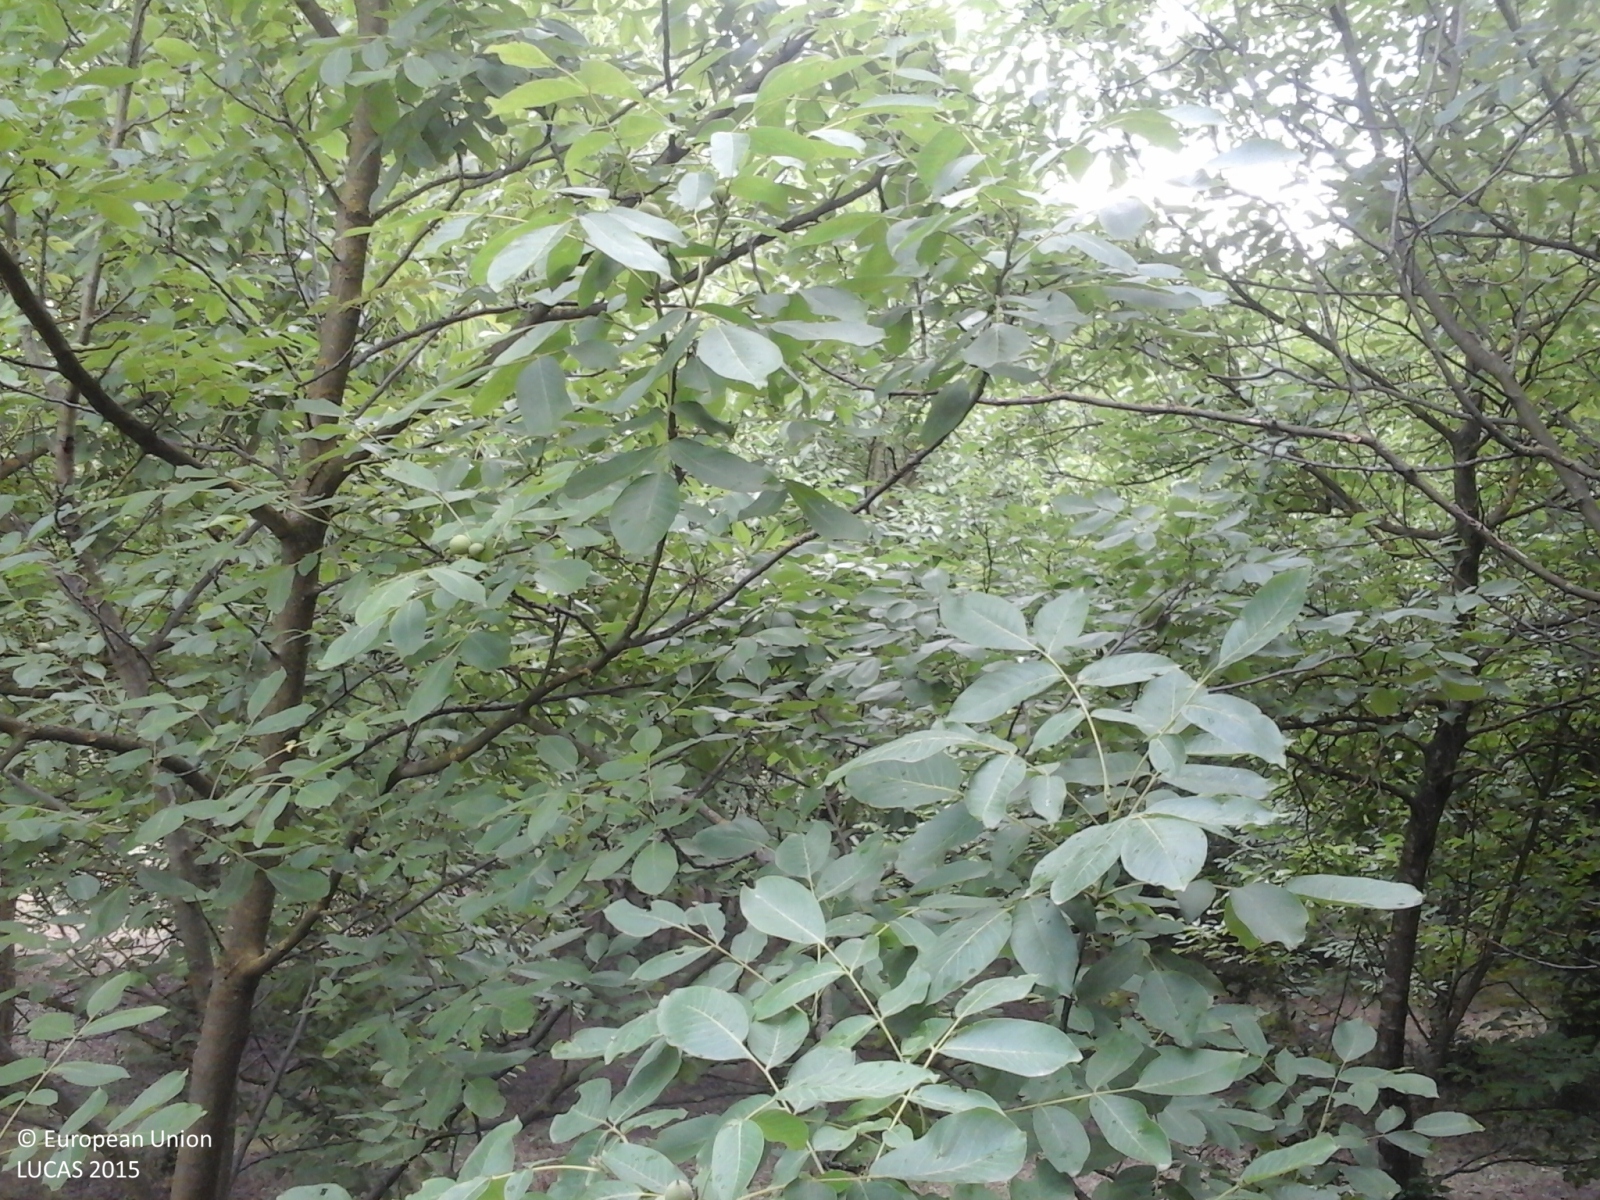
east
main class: Cropland
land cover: Nuts trees
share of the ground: > 75 %
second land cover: Grassland without tree/shrub cover
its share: 50 - 75 %
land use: Agriculture (excluding fallow land and kitchen gardens)
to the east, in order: Nuts trees; Grassland without tree/shrub cover; Broadleaved woodland; Grassland without tree/shrub cover; Olive groves; Shrubland without tree cover; Nuts trees; Grassland without tree/shrub cover
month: June
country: IT
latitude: 41.8124
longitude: 13.0582
